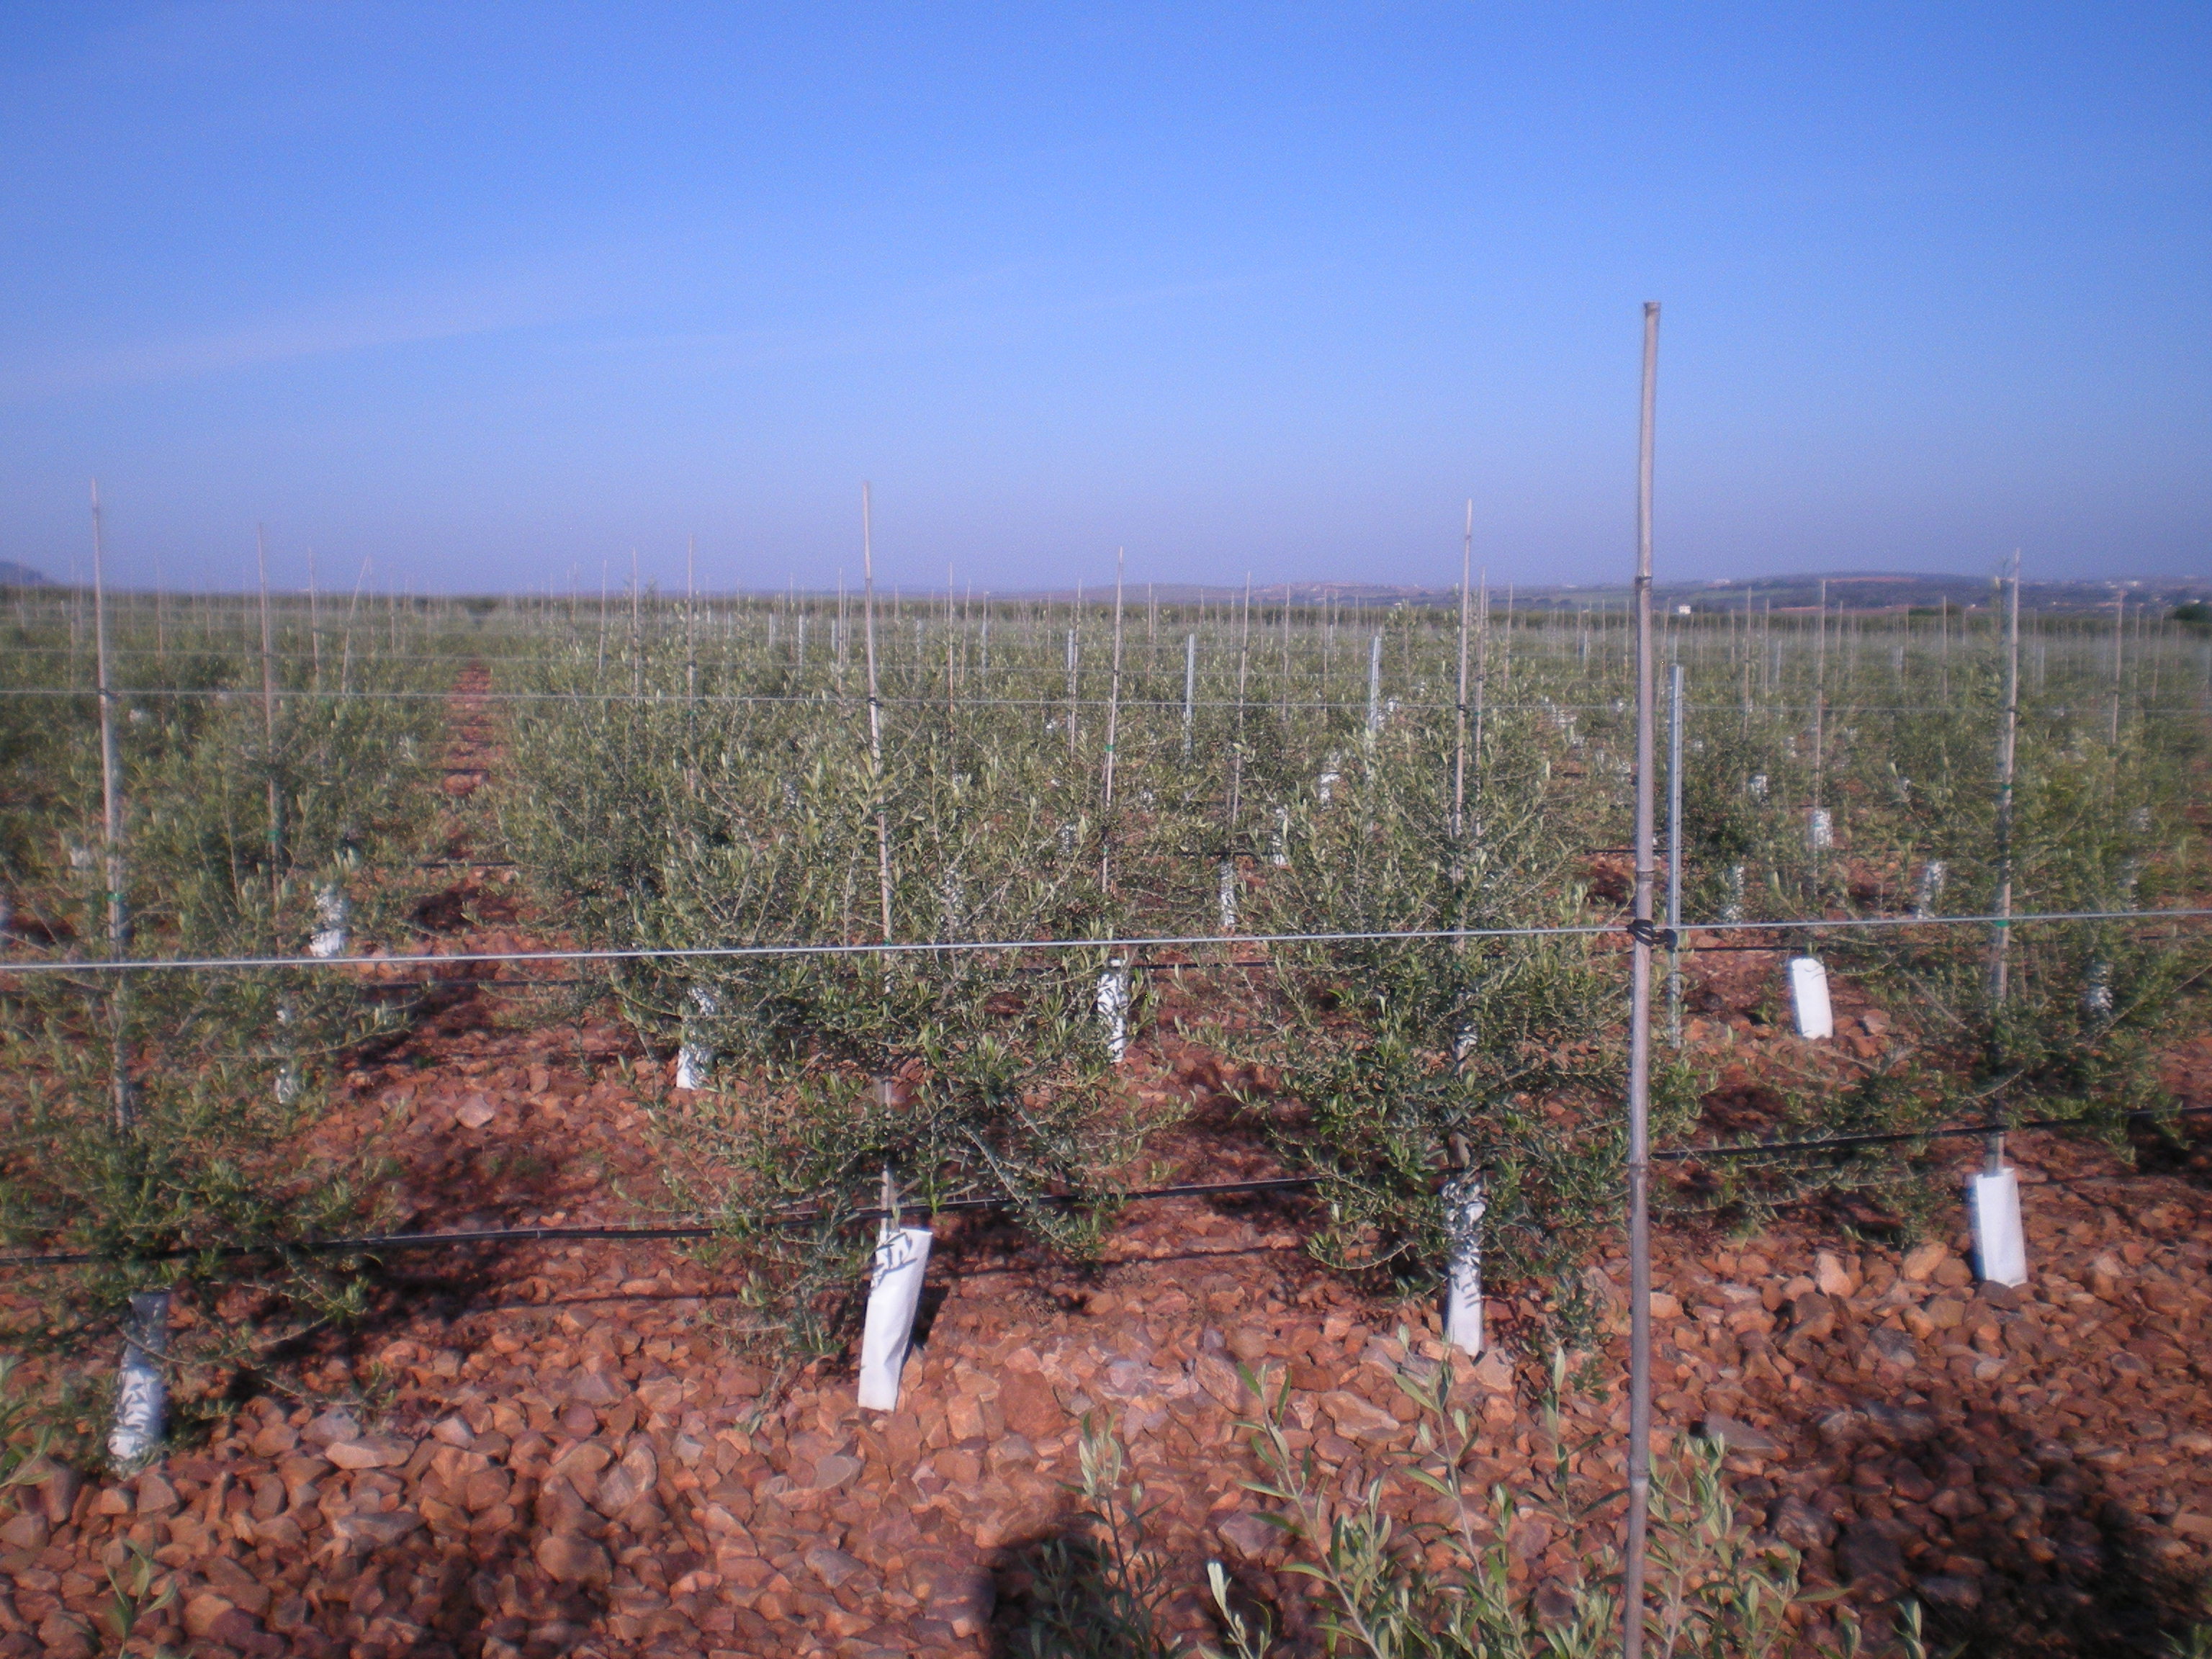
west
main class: Cropland
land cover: Olive groves
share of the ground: 10 - 25 %
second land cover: Other bare soil
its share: > 75 %
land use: Agriculture (excluding fallow land and kitchen gardens)
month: April
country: ES
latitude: 38.8781
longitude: -3.5821
